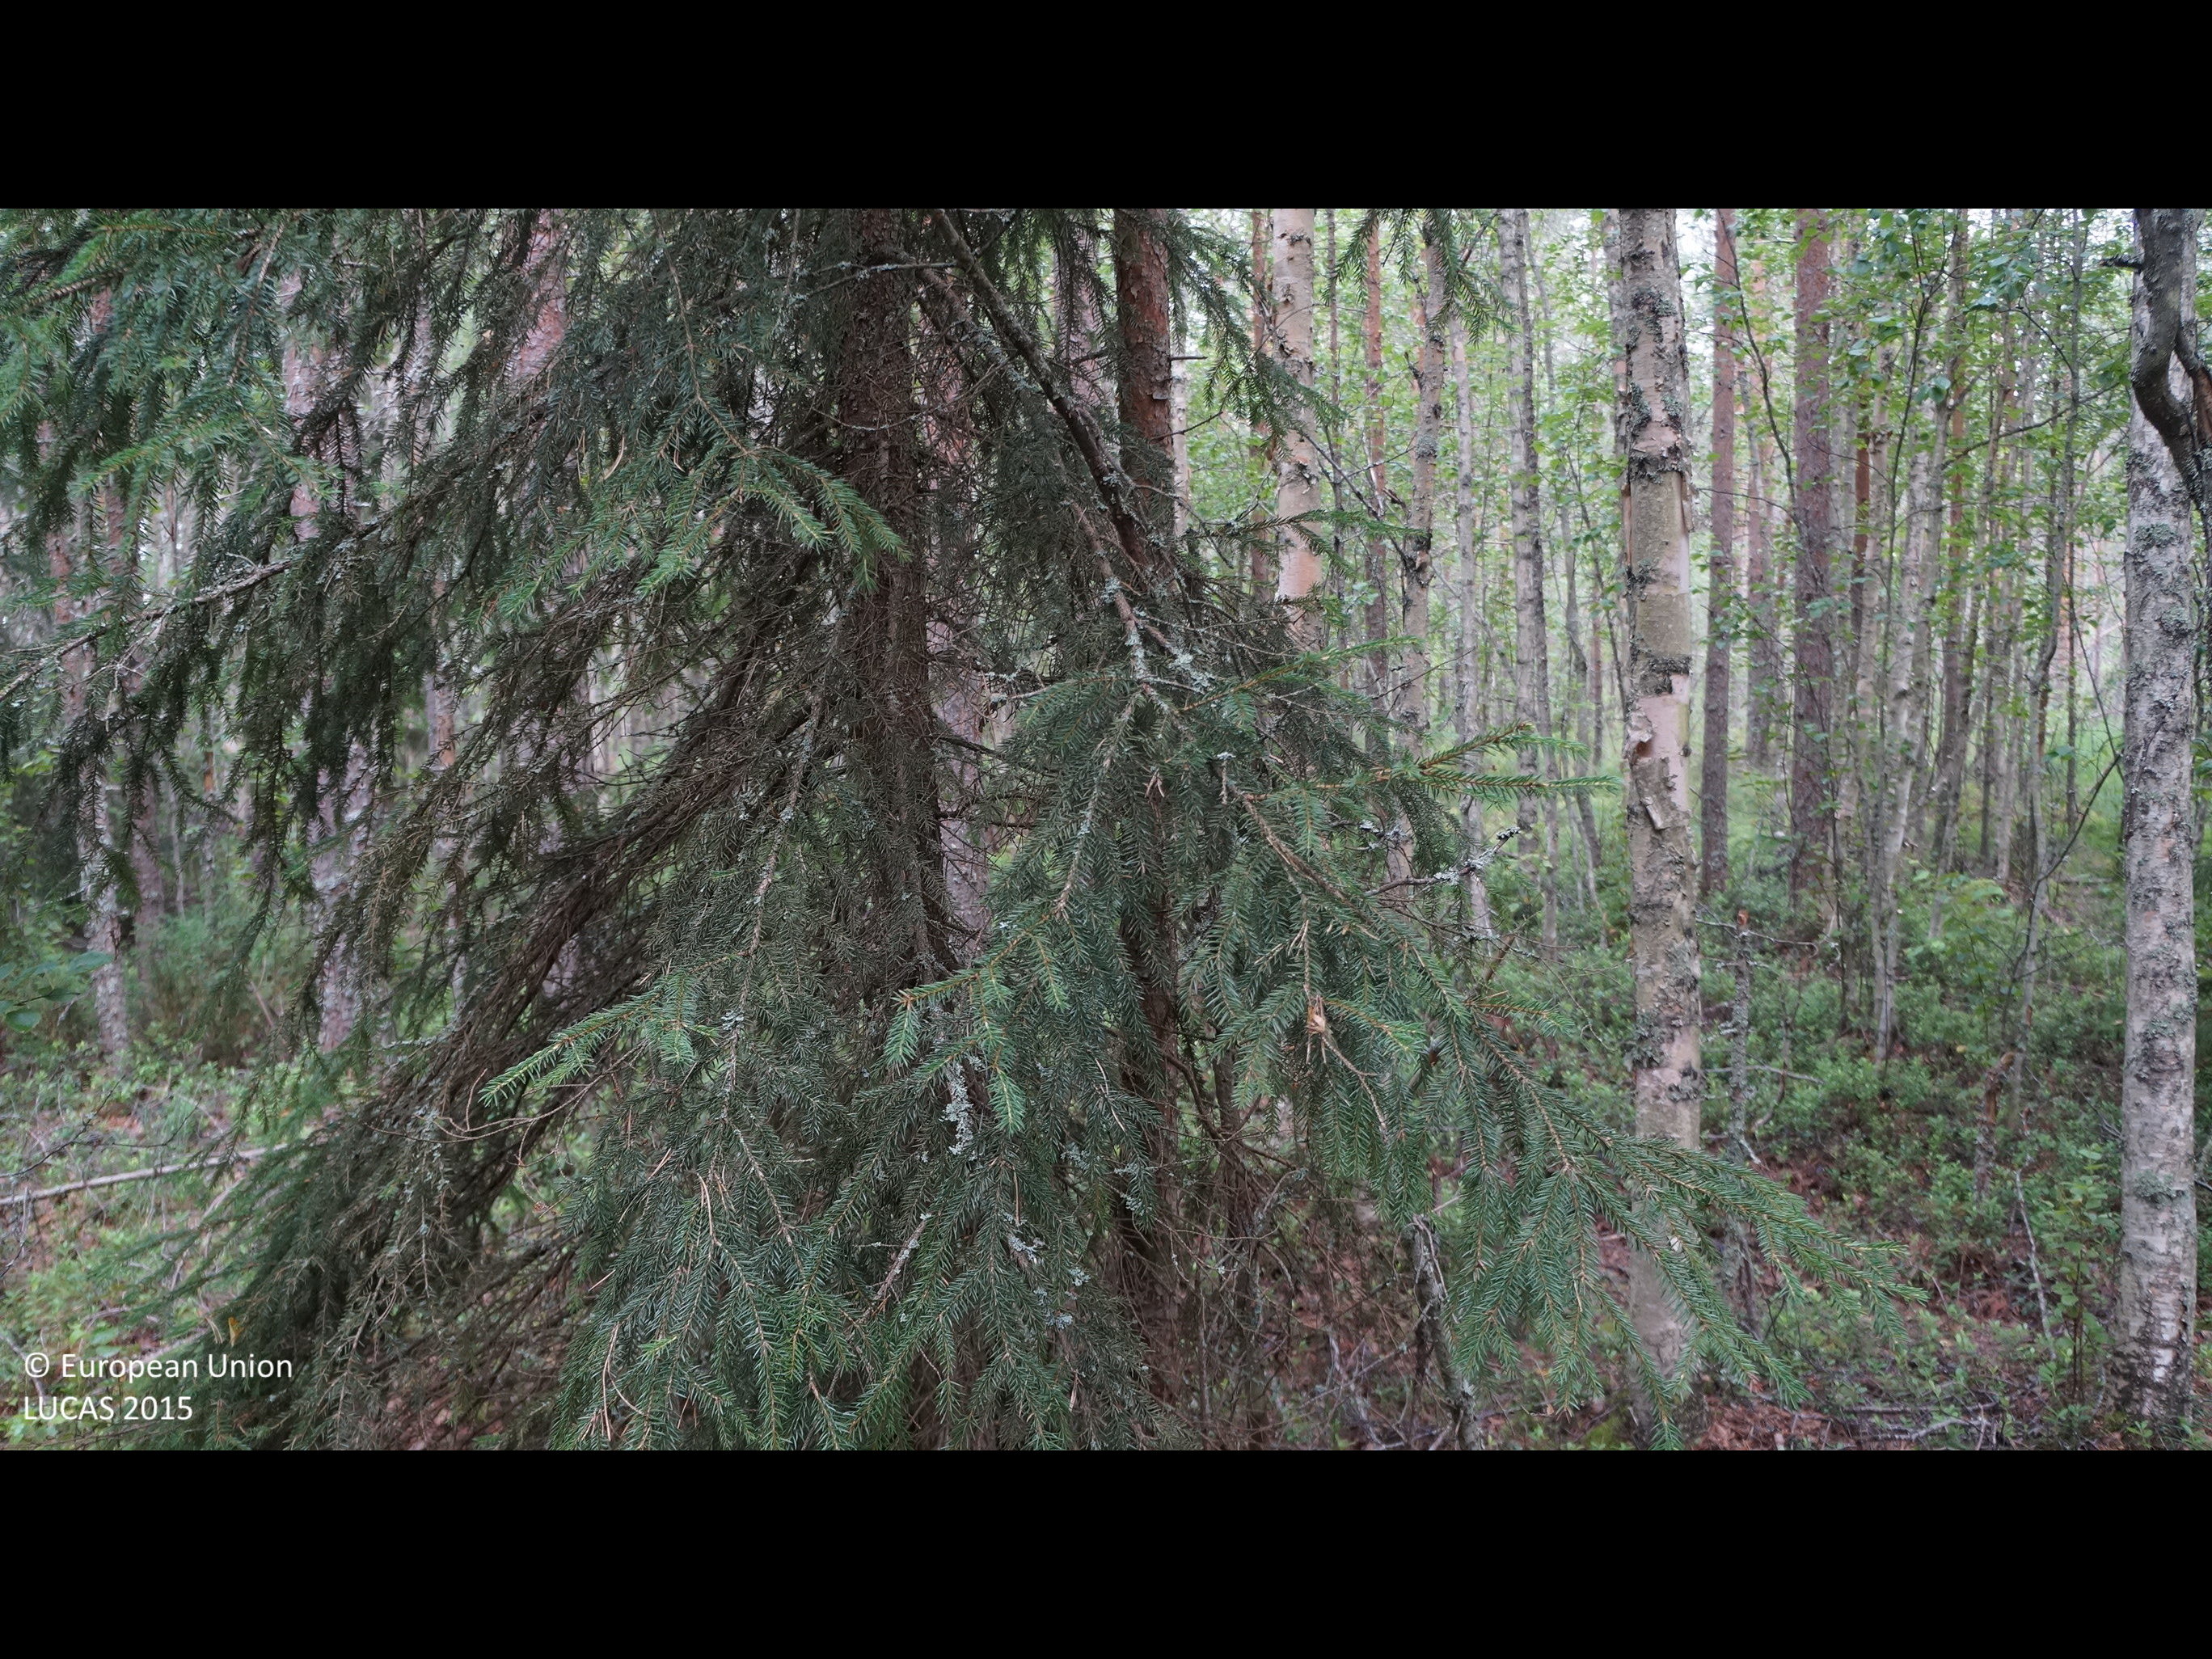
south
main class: Woodland
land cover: Pine dominated mixed woodland
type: boreal forest
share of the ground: > 75 %
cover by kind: broadleaved forest trees 40 %, coniferous forest trees 35 %, shrubs 10 %, lichens and mosses 10 %, herbaceous plants 5 %
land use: Forestry
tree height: > 5 m
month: July
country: FI
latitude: 63.9870
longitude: 24.4821
